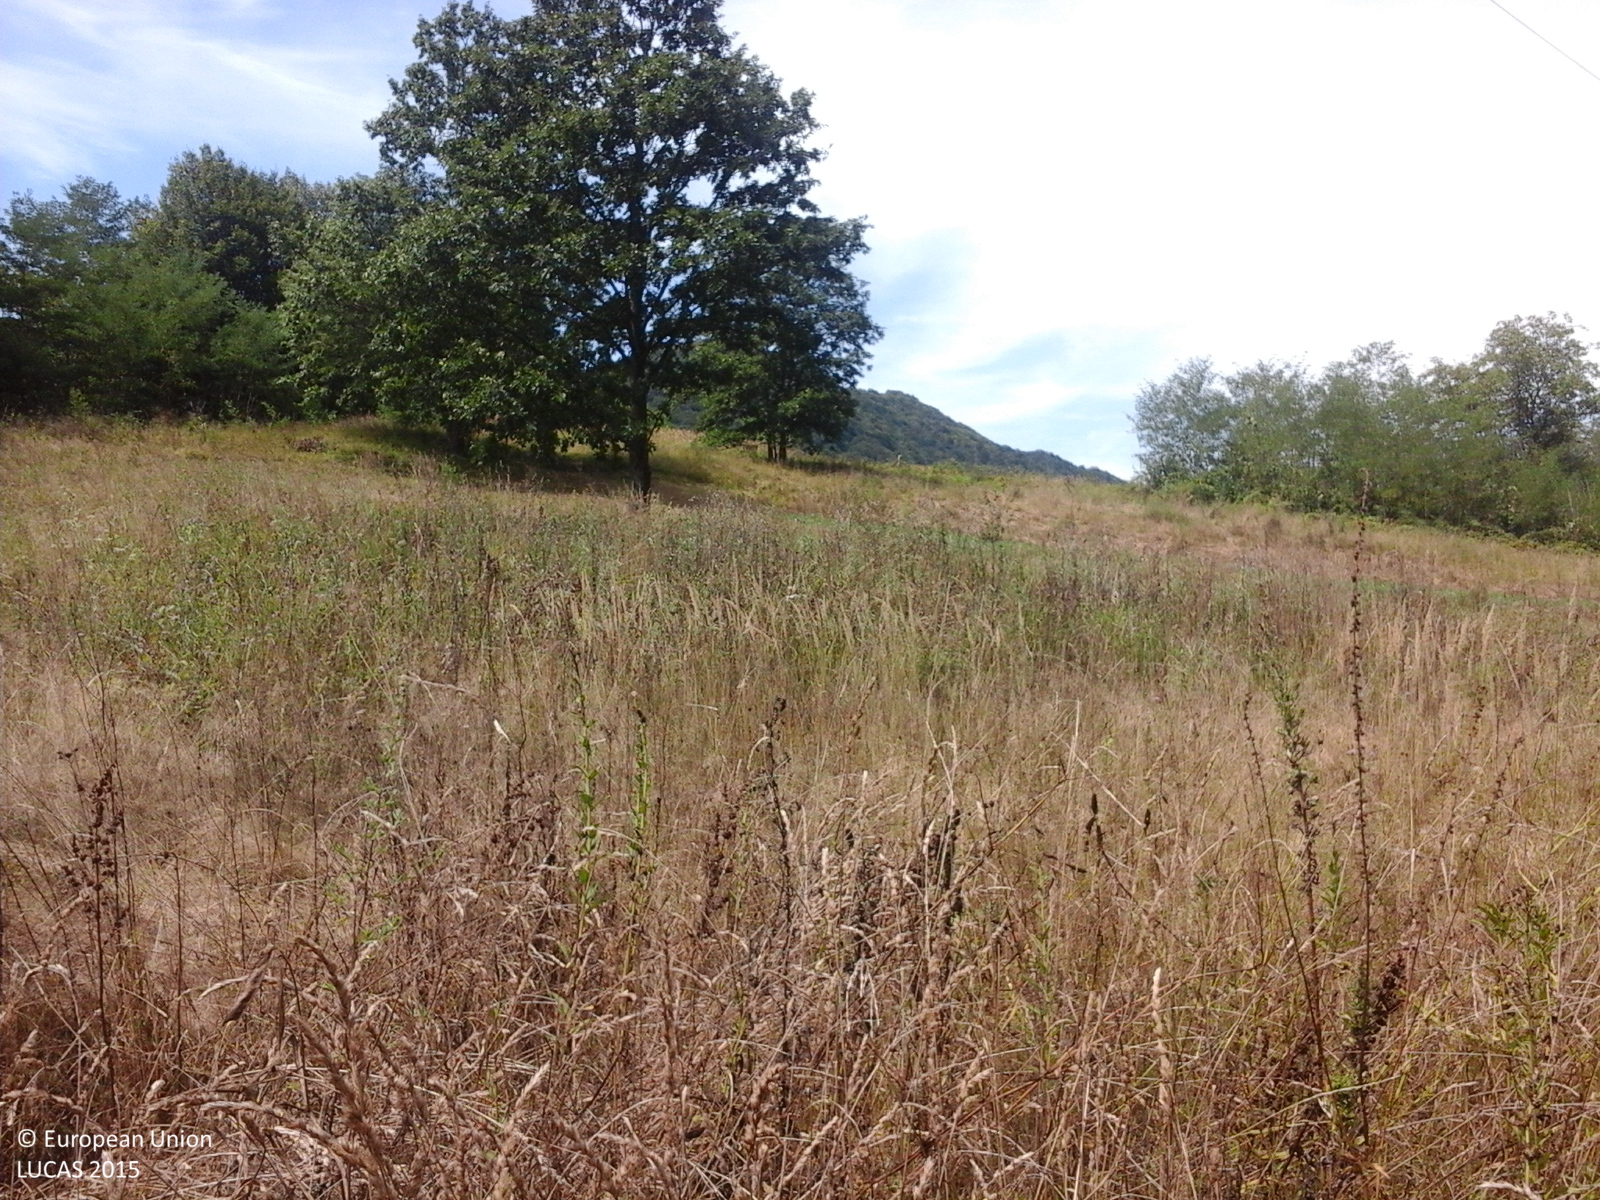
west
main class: Grassland
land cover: Spontaneously vegetated surfaces
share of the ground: > 75 %
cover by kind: herbaceous plants 100 %
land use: Fallow land
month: August
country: RO
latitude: 44.8334
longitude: 21.8594
